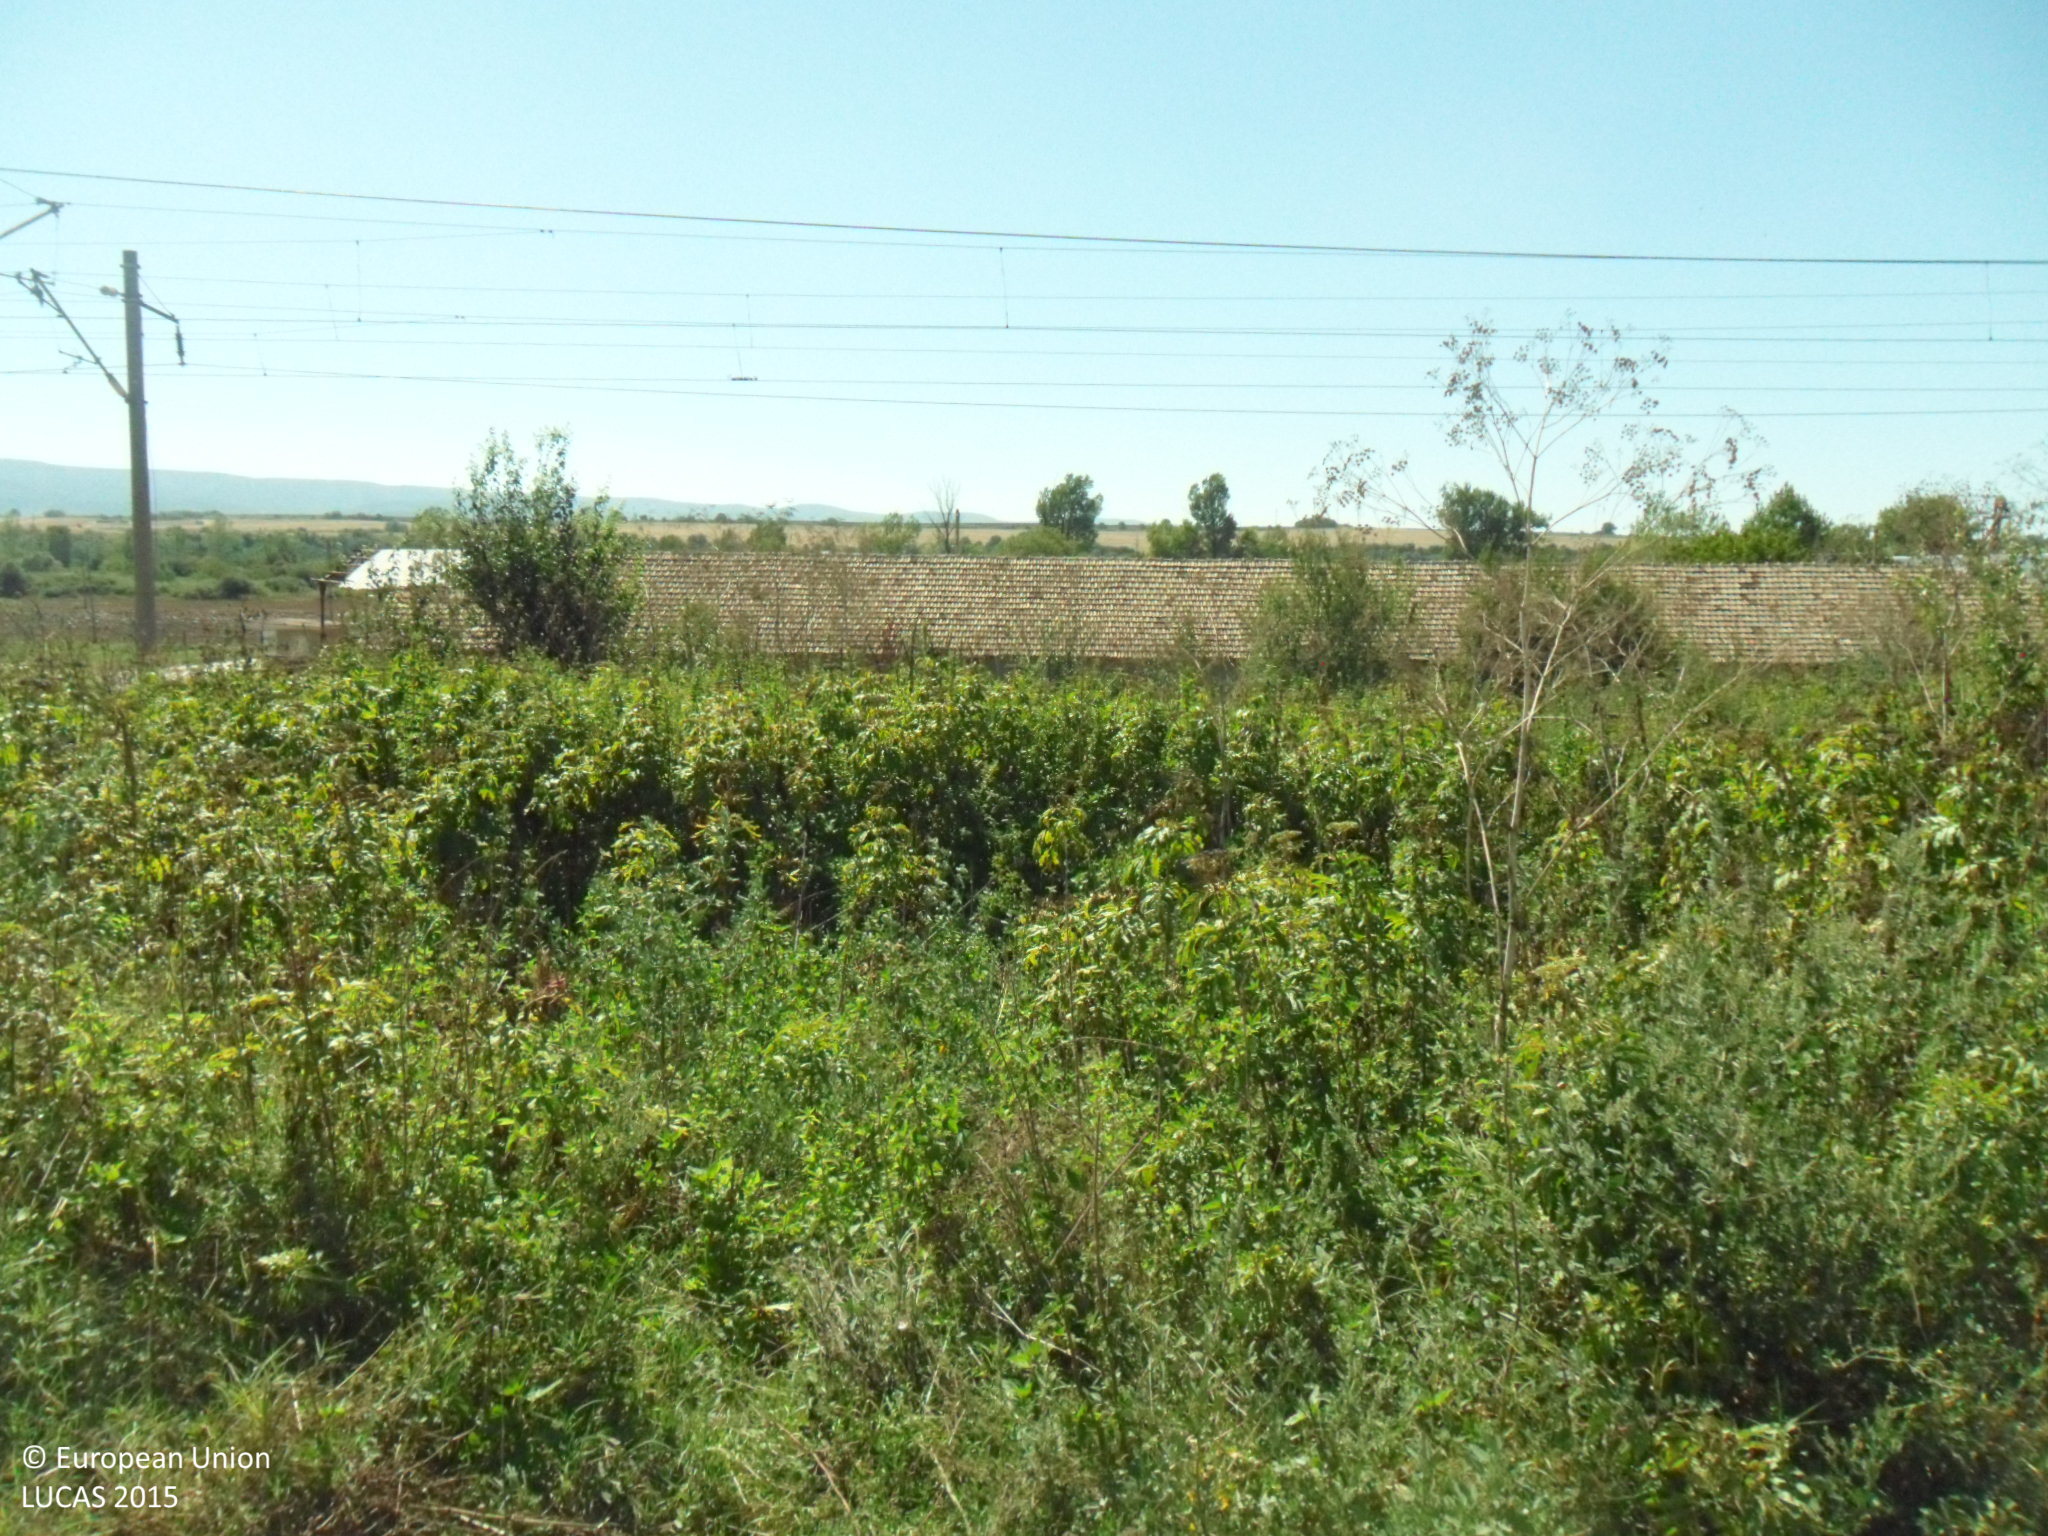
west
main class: Grassland
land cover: Grassland without tree/shrub cover
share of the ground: > 75 %
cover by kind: herbaceous plants 85 %, unconsolidated bare surface 10 %, shrubs 5 %
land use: Residential
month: September
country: BG
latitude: 43.2278
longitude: 26.7919
